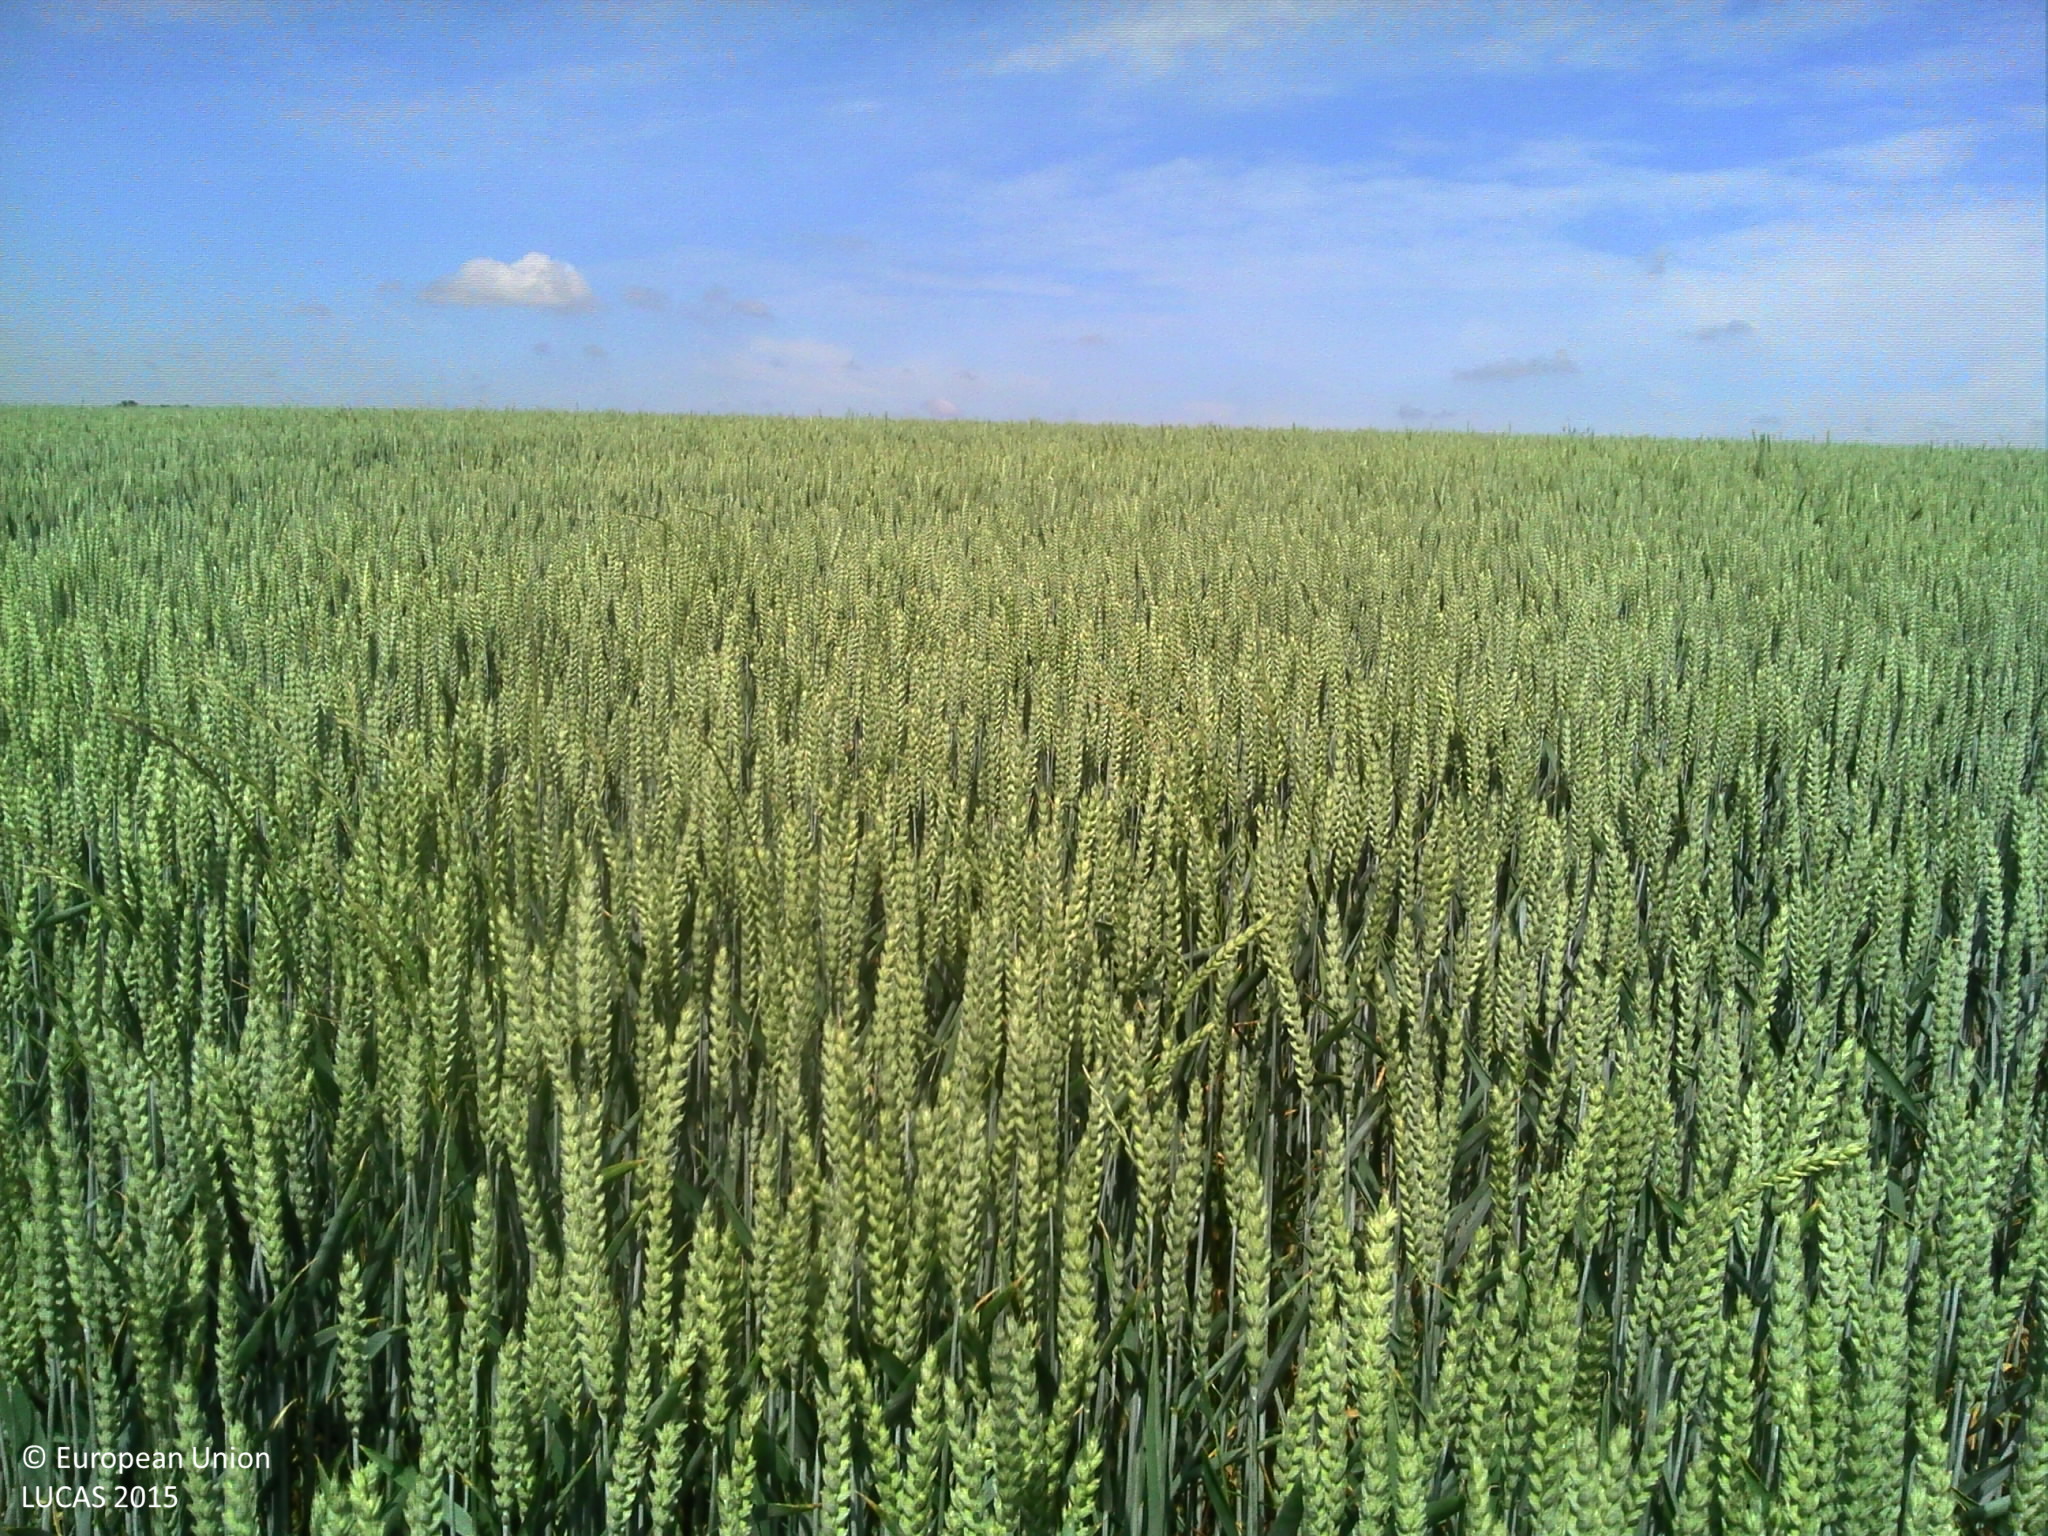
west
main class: Cropland
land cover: Common wheat
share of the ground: > 75 %
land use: Agriculture (excluding fallow land and kitchen gardens)
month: June
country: FR
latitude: 49.7062
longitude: 2.2907
